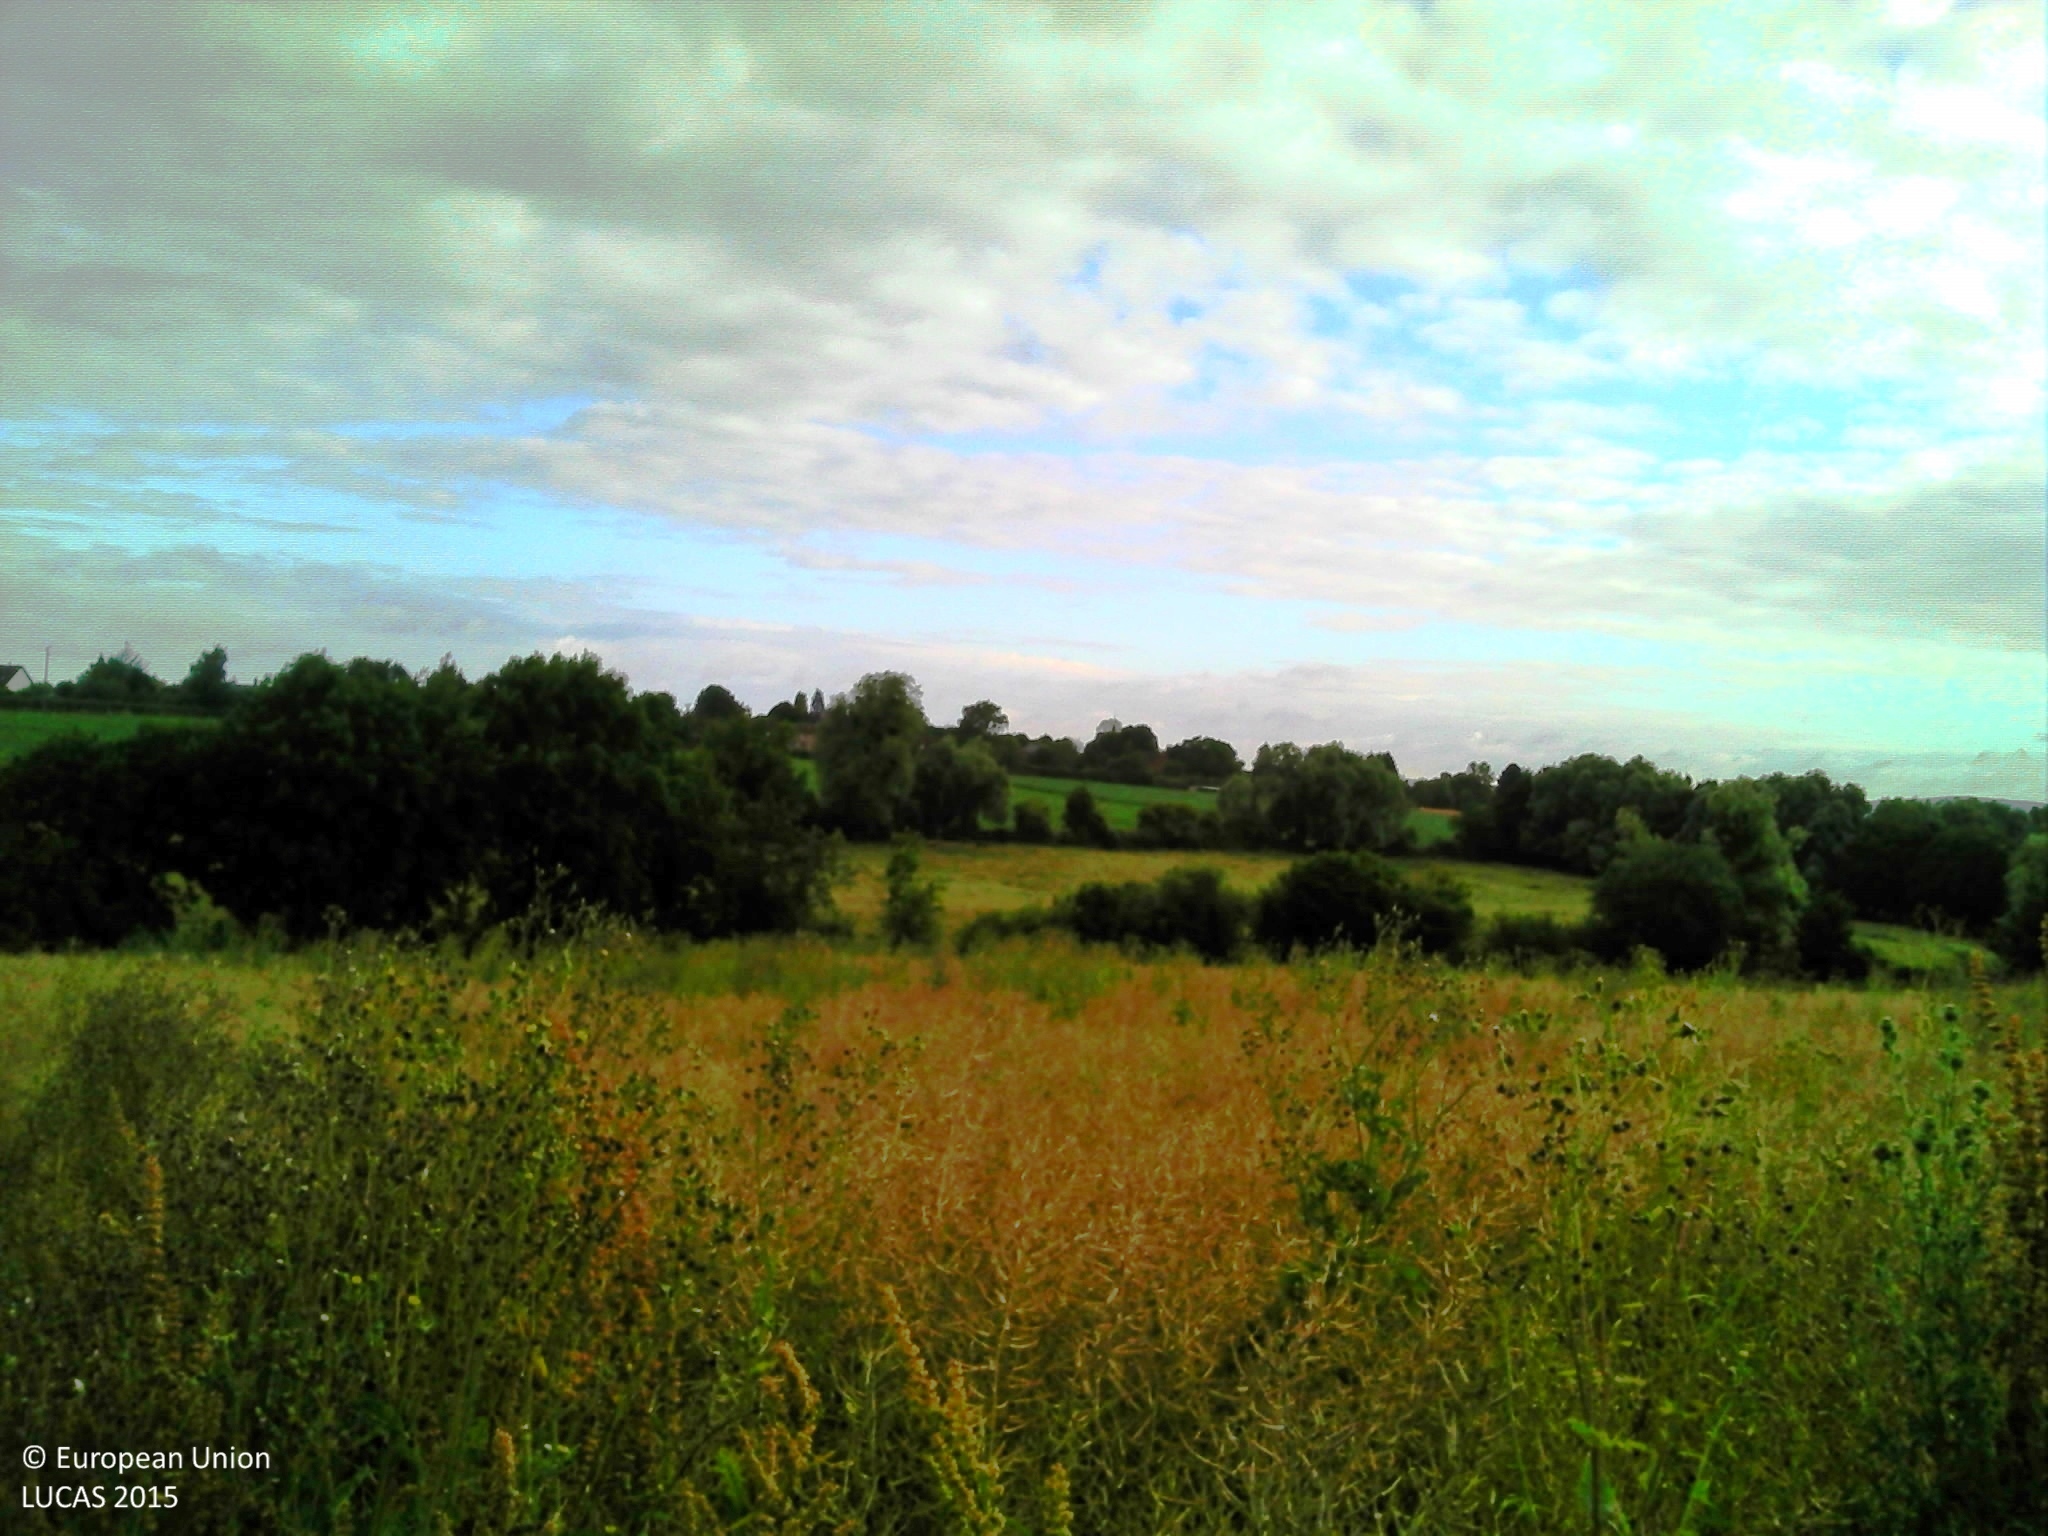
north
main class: Cropland
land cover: Rape and turnip rape
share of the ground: > 75 %
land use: Agriculture (excluding fallow land and kitchen gardens)
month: July
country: FR
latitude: 49.4093
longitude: 1.9218
